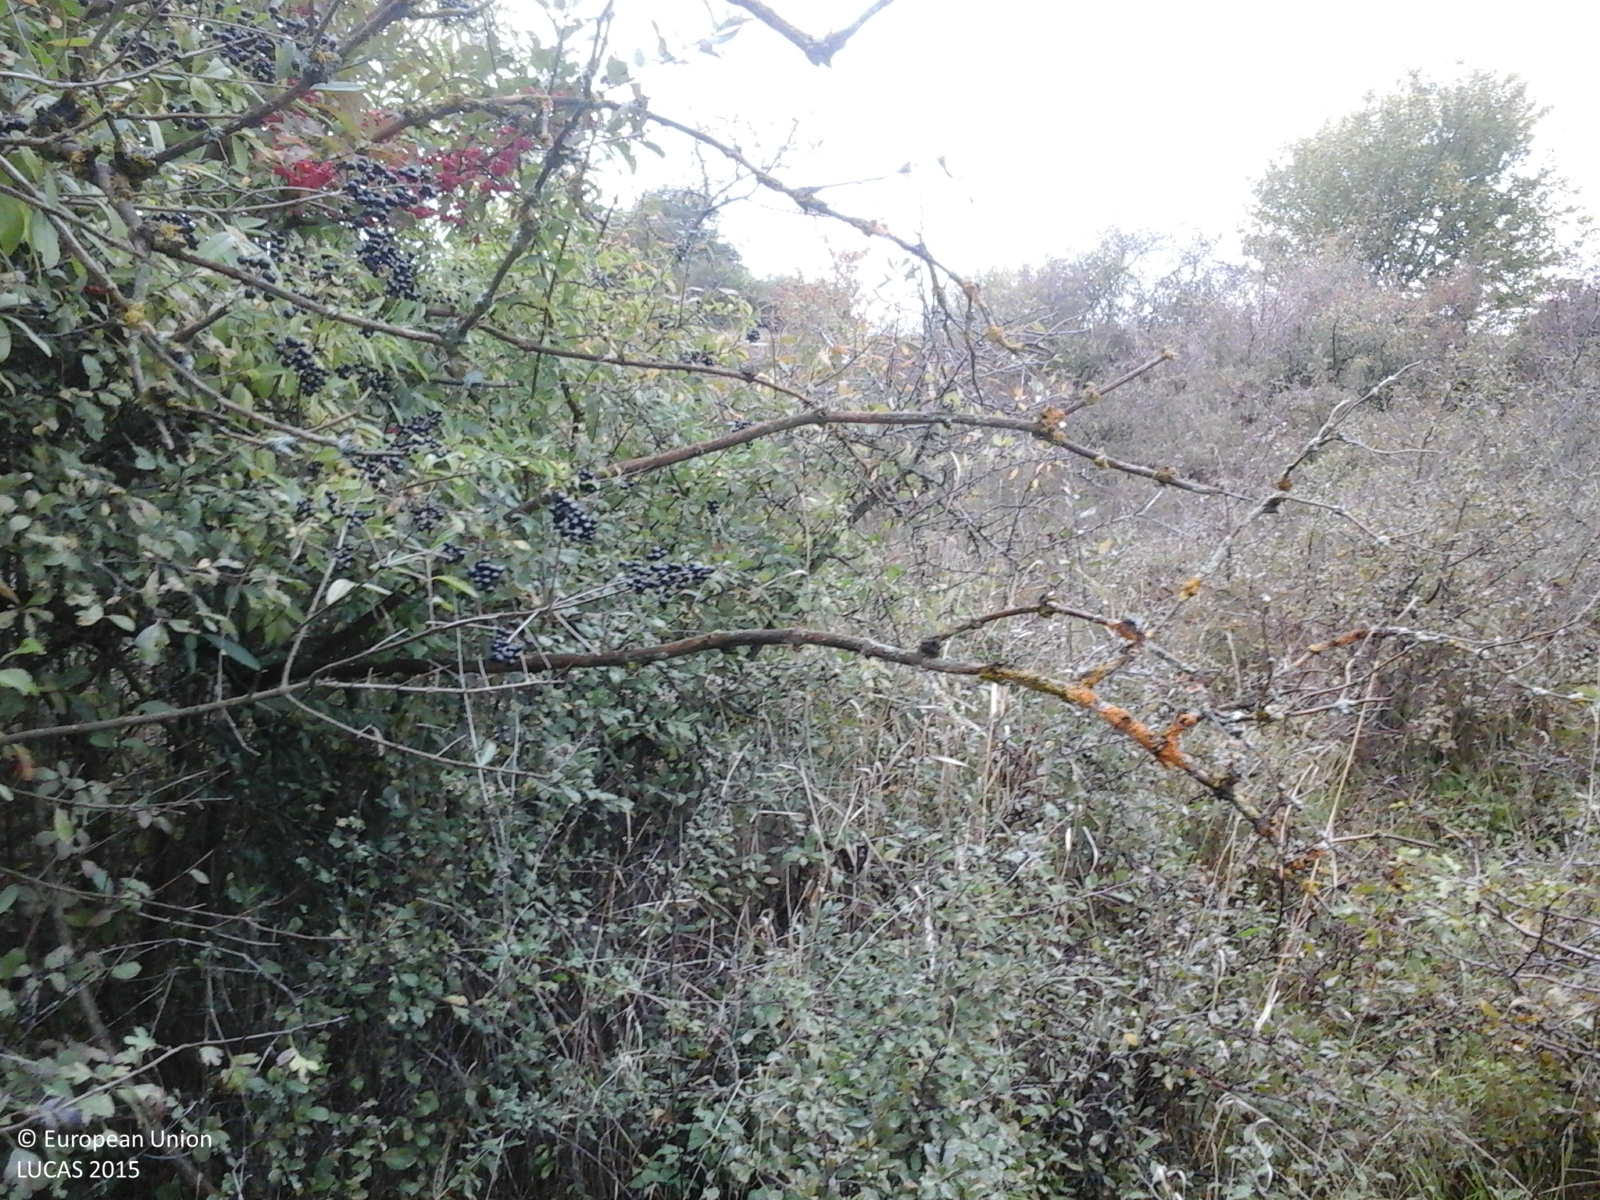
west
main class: Shrubland
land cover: Shrubland without tree cover
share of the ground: > 75 %
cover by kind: herbaceous plants 90 %, shrubs 10 %
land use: Semi-natural and natural areas not in use
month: October
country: RO
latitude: 45.8646
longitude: 24.1282
